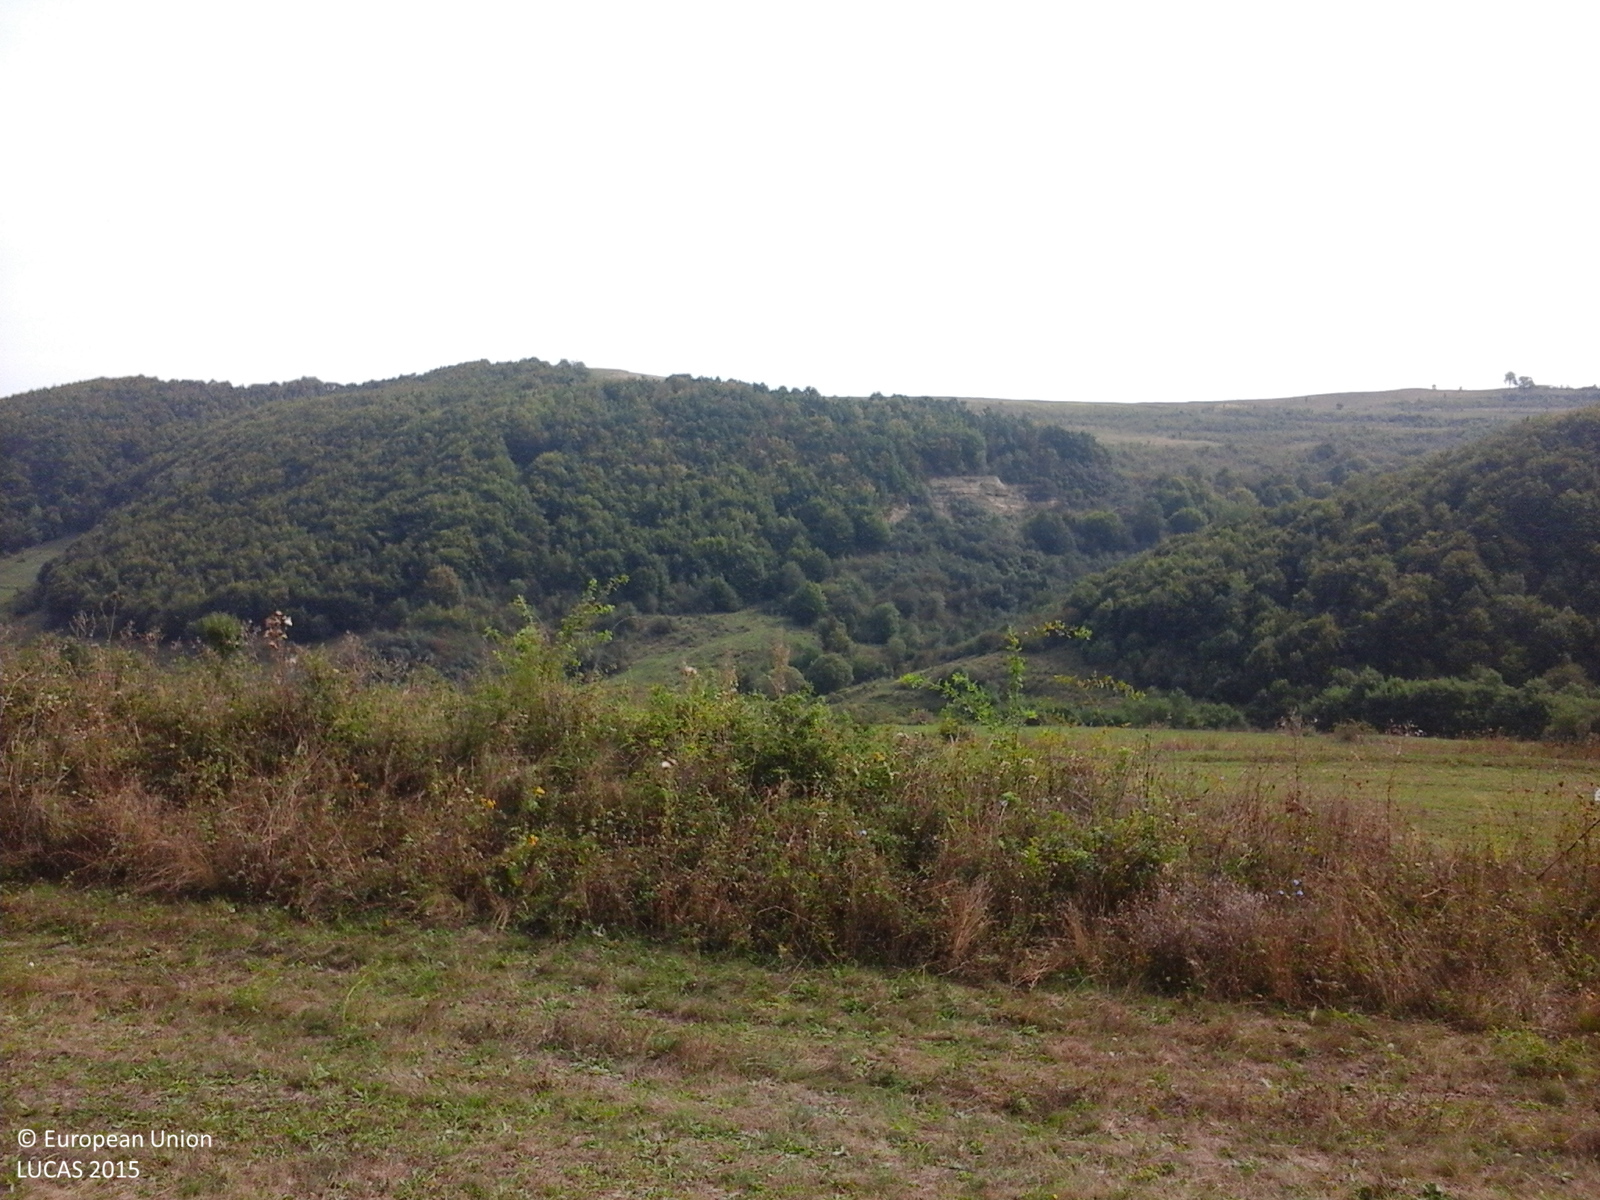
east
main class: Grassland
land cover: Grassland without tree/shrub cover
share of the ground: > 75 %
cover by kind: herbaceous plants 100 %
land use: Agriculture (excluding fallow land and kitchen gardens)
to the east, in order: Grassland without tree/shrub cover; Shruby margins; Grassland without tree/shrub cover; Spontaneously vegetated surfaces; Abandoned hedges; Grassland without tree/shrub cover; Abandoned hedges; Grassland without tree/shrub cover; Shruby margins; Grassland without tree/shrub cover; Shruby margins; Tracks; Lines of trees; Shruby margins; Grassland without tree/shrub cover
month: September
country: RO
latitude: 47.1335
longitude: 23.6405
